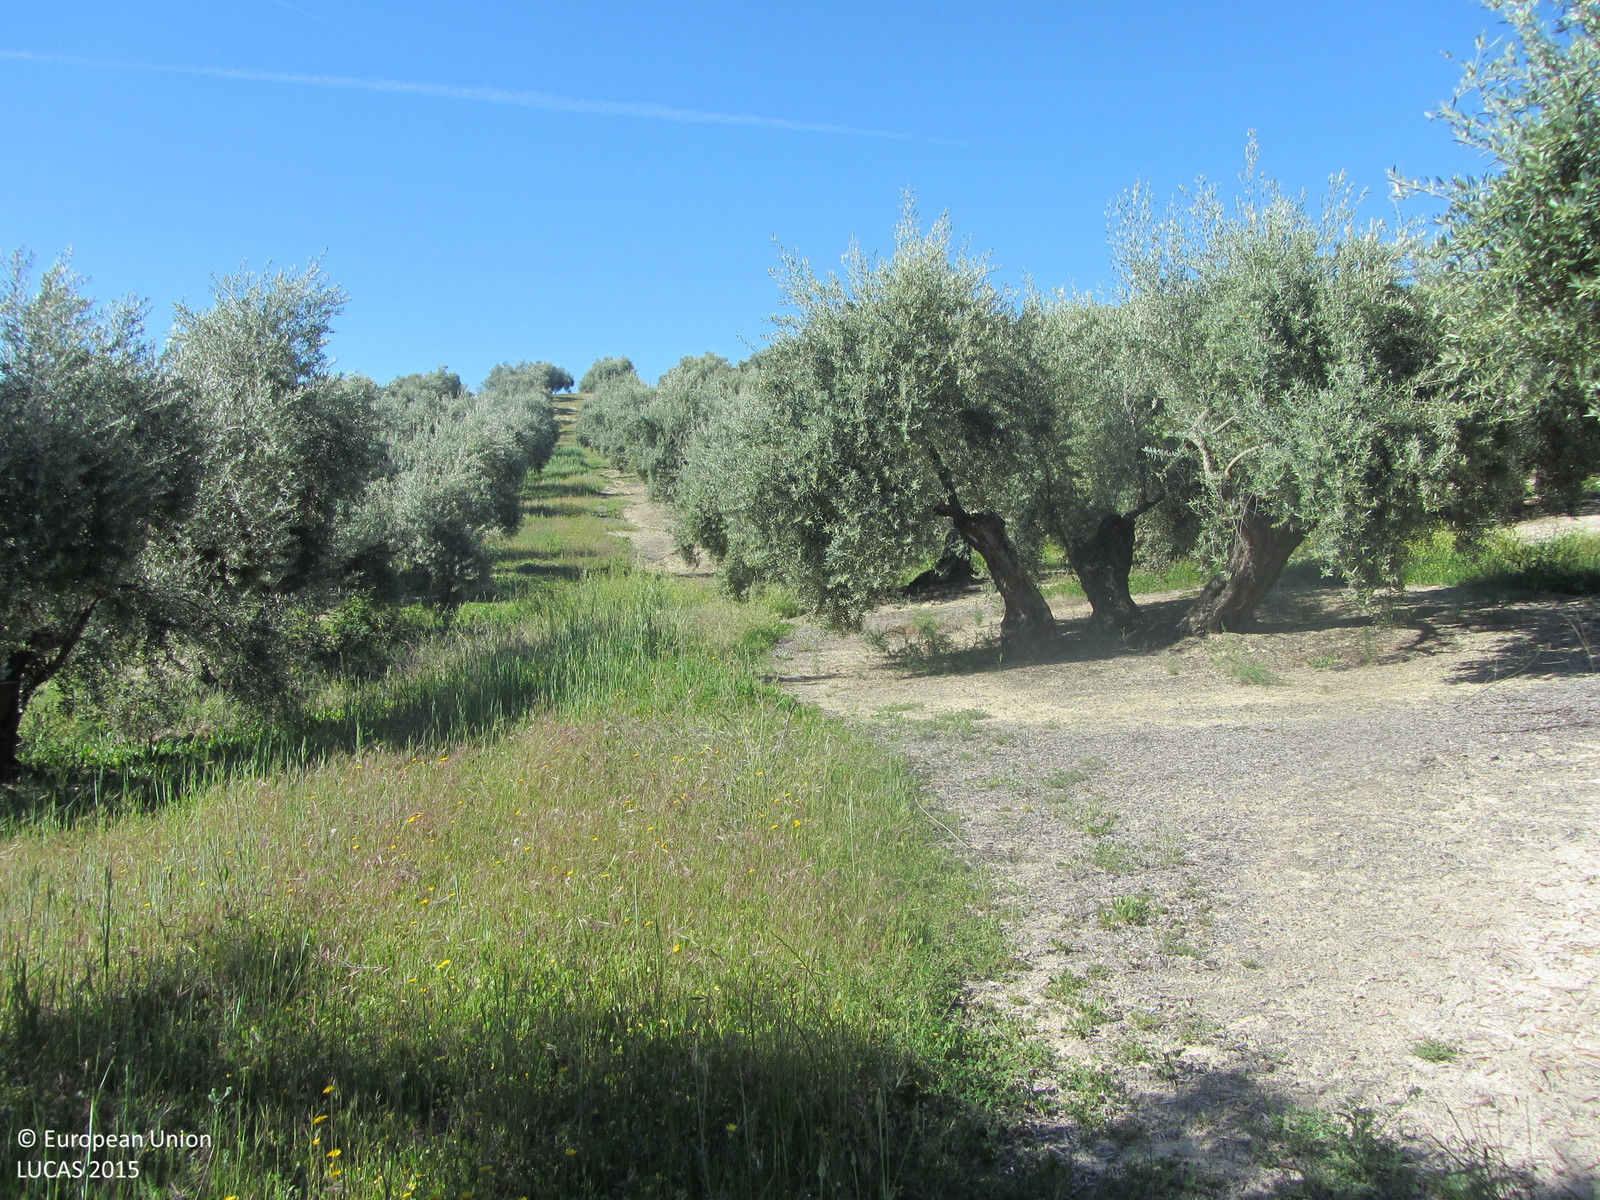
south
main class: Cropland
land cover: Olive groves
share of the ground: 25 - 50 %
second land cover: Spontaneously vegetated surfaces
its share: > 75 %
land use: Agriculture (excluding fallow land and kitchen gardens)
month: May
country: ES
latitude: 38.1116
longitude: -3.0345
